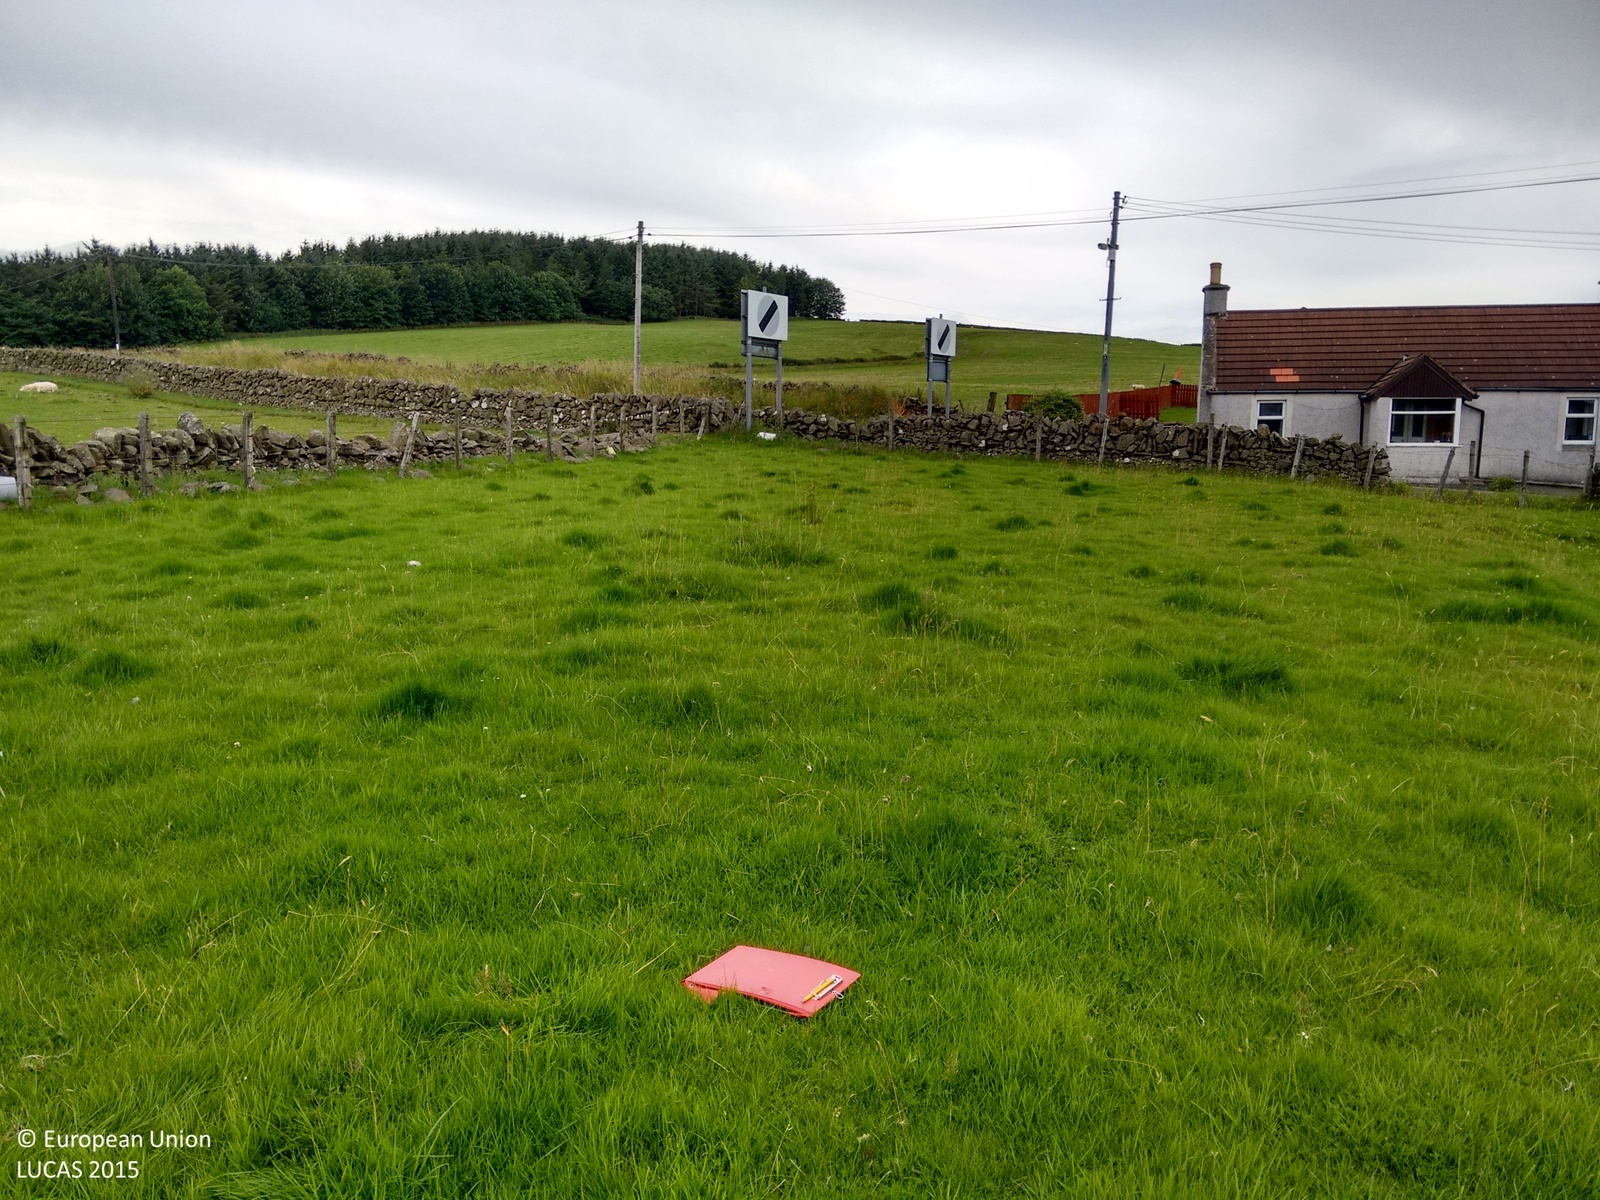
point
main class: Grassland
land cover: Grassland without tree/shrub cover
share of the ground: 50 - 75 %
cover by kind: herbaceous plants 95 %, lichens and mosses 5 %
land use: Agriculture (excluding fallow land and kitchen gardens)
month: August
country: GB
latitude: 55.4946
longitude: -3.7762
